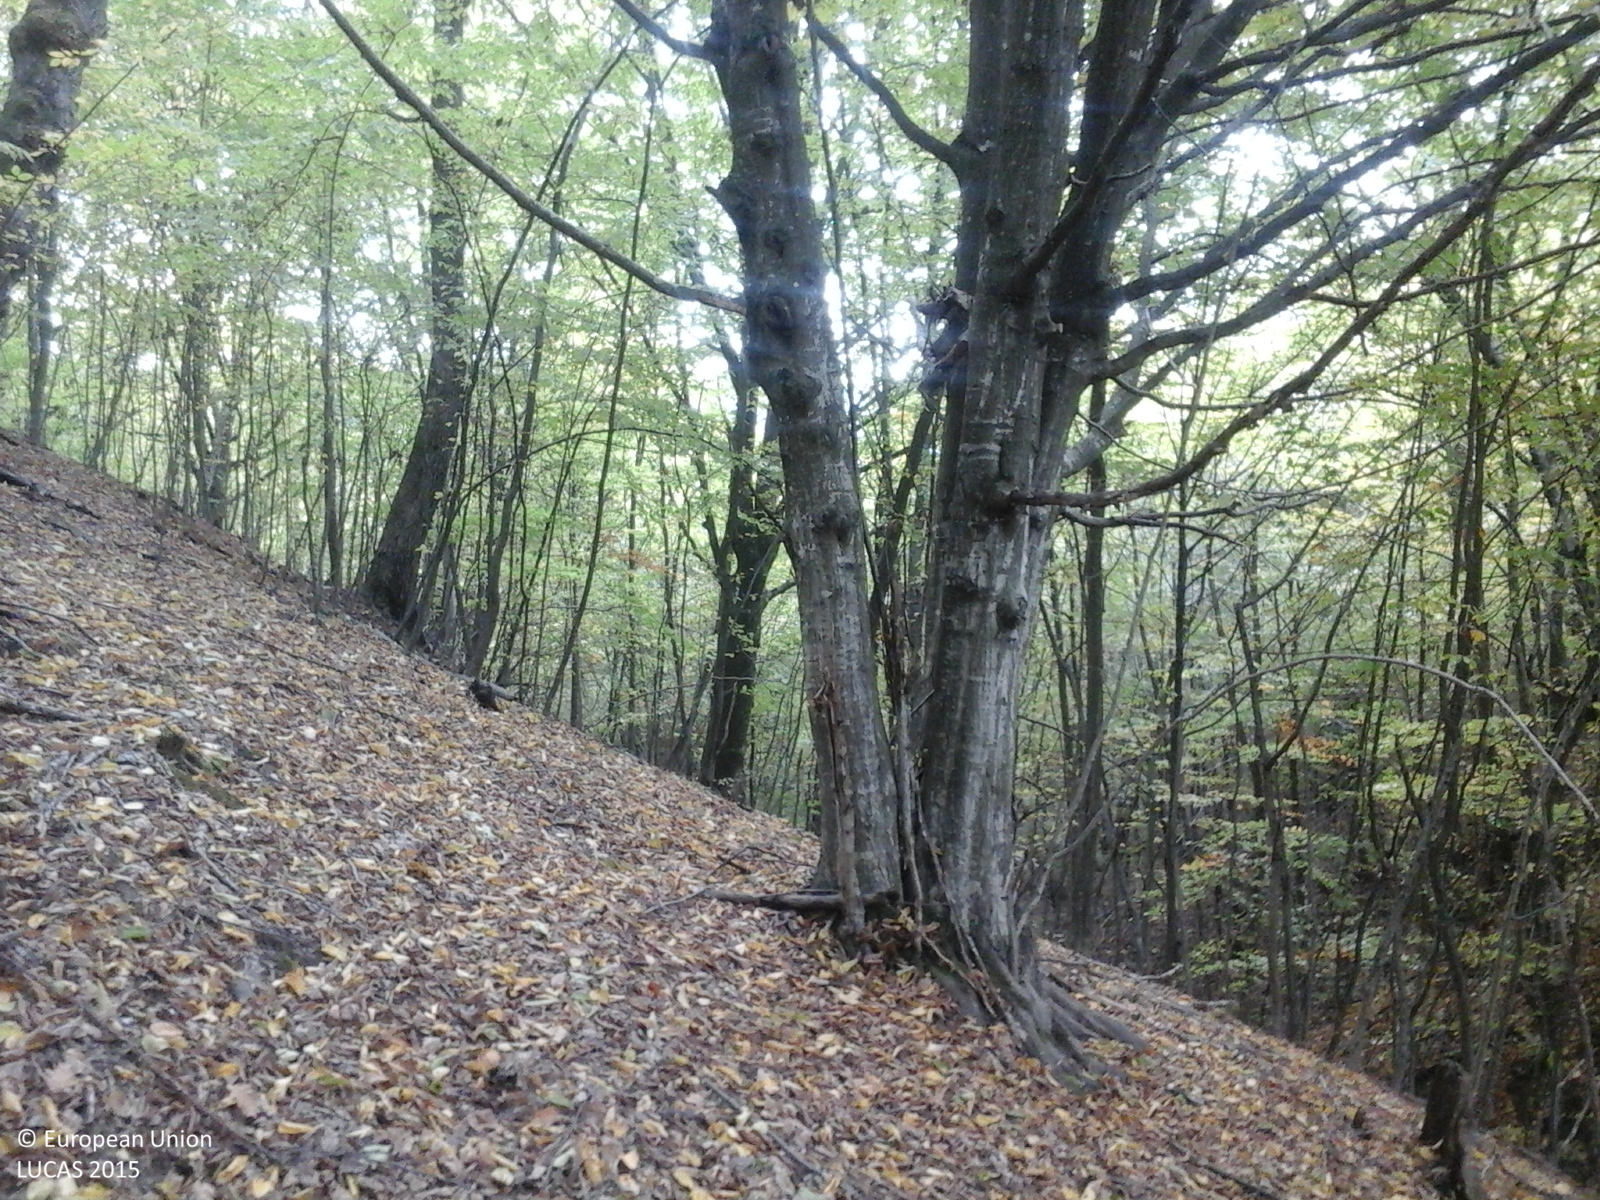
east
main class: Woodland
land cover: Broadleaved woodland
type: mesophytic deciduous forest
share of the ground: > 75 %
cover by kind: broadleaved forest trees 100 %
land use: Forestry
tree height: > 5 m
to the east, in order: Broadleaved woodland; Grassland without tree/shrub cover
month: October
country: RO
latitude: 46.0067
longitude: 25.8292
